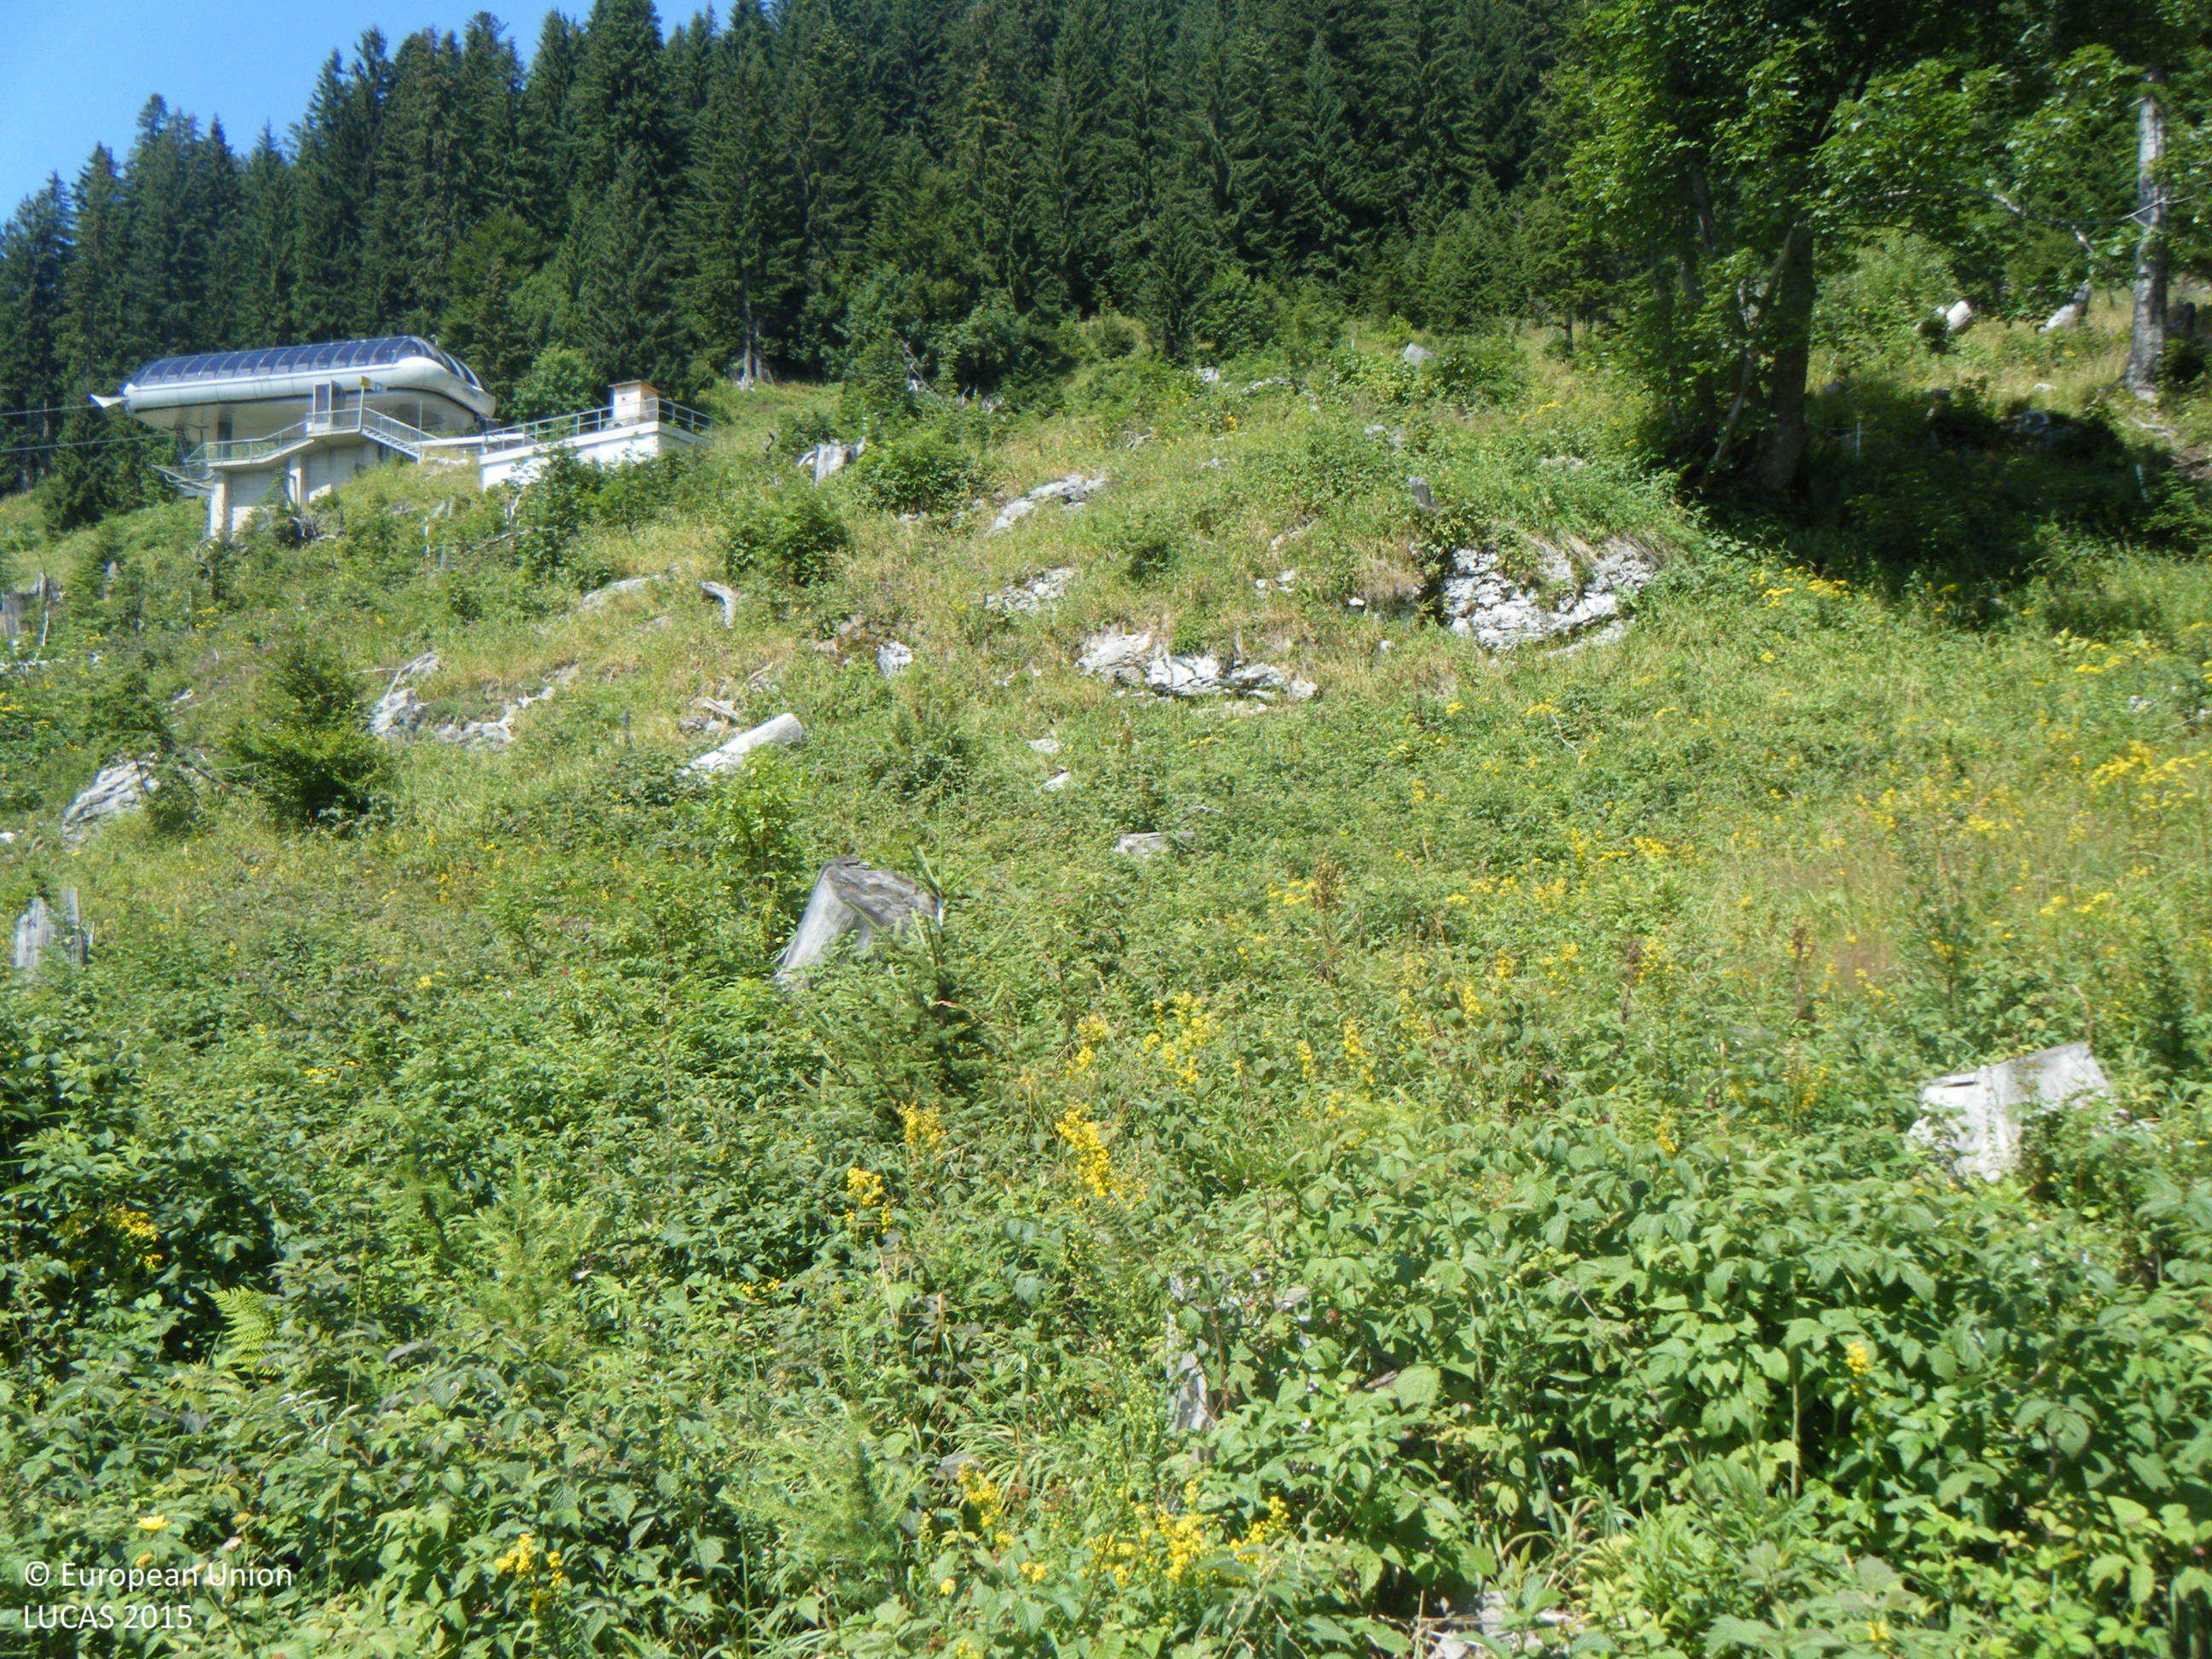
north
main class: Shrubland
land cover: Shrubland with sparse tree cover
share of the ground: 50 - 75 %
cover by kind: shrubs 65 %, herbaceous plants 30 %, broadleaved forest trees 5 %
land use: Forestry
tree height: < 5 m
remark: Clear cut
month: July
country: AT
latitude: 47.6548
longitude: 13.7667
